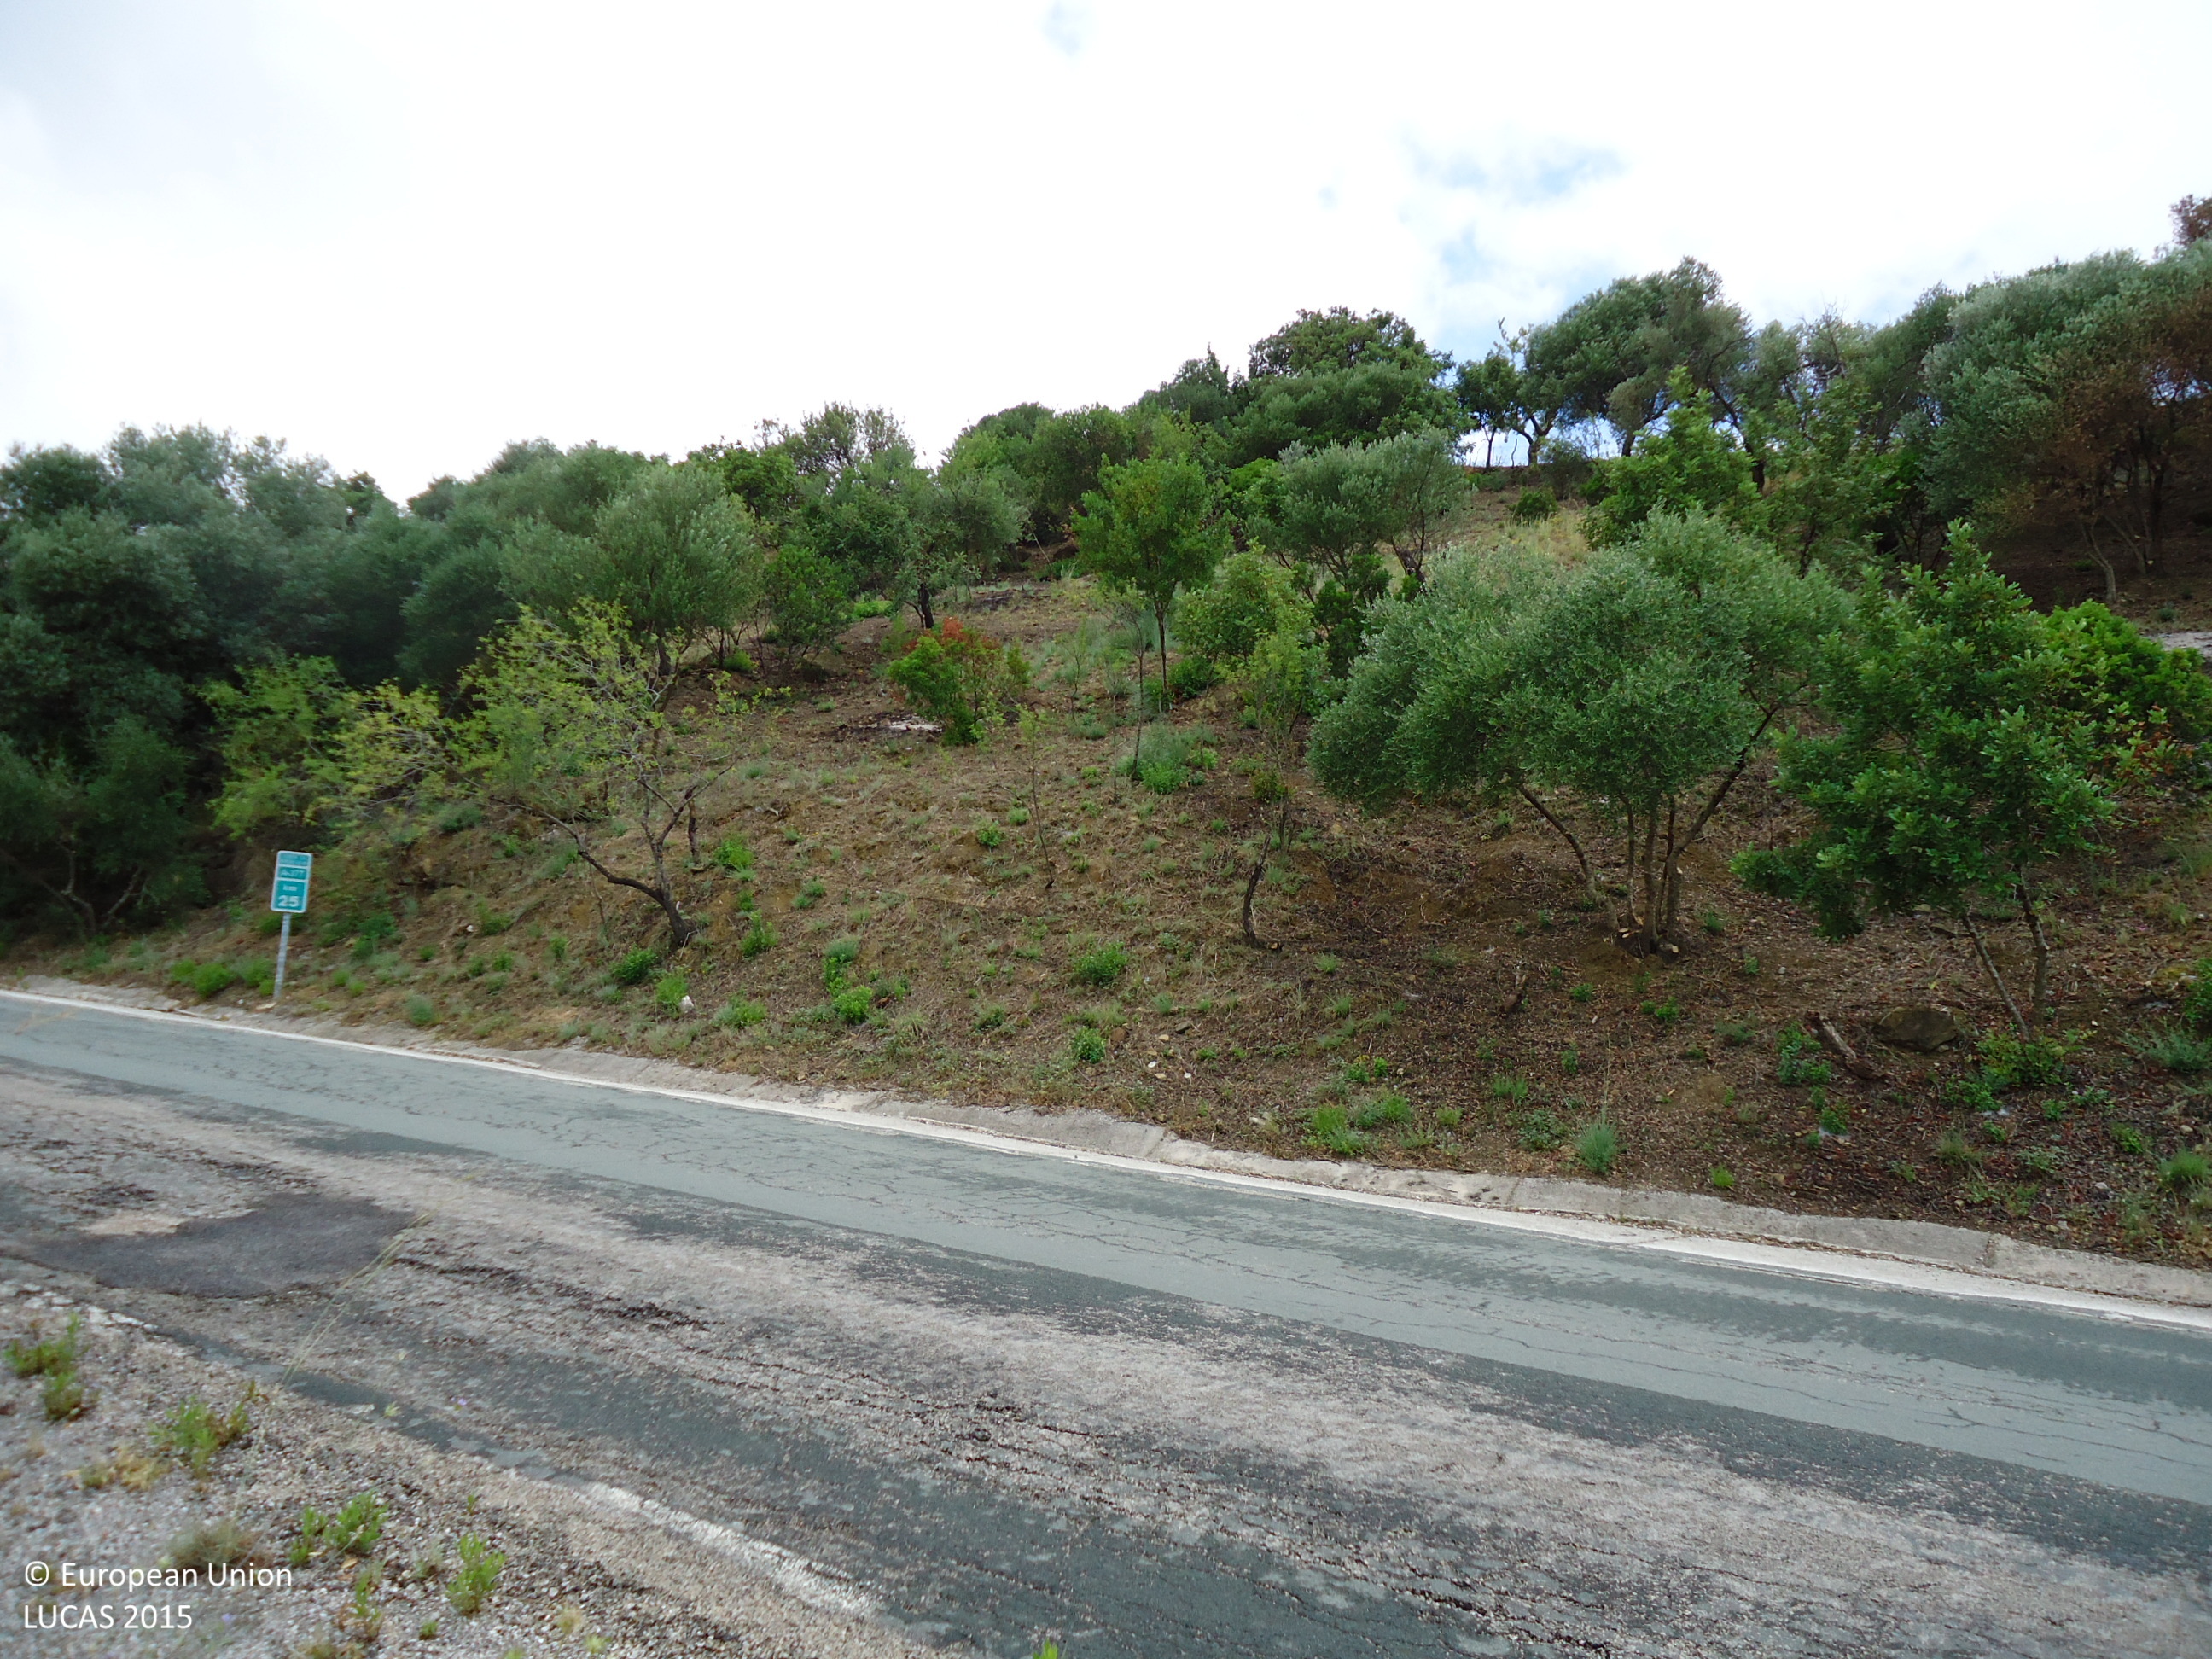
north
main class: Woodland
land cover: Broadleaved woodland
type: broadleaved evergreen forest
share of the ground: 25 - 50 %
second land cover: Grassland without tree/shrub cover
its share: > 75 %
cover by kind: herbaceous plants 55 %, broadleaved forest trees 45 %
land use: Forestry
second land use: Agriculture (excluding fallow land and kitchen gardens)
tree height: > 5 m
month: June
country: ES
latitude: 36.4974
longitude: -5.3248
